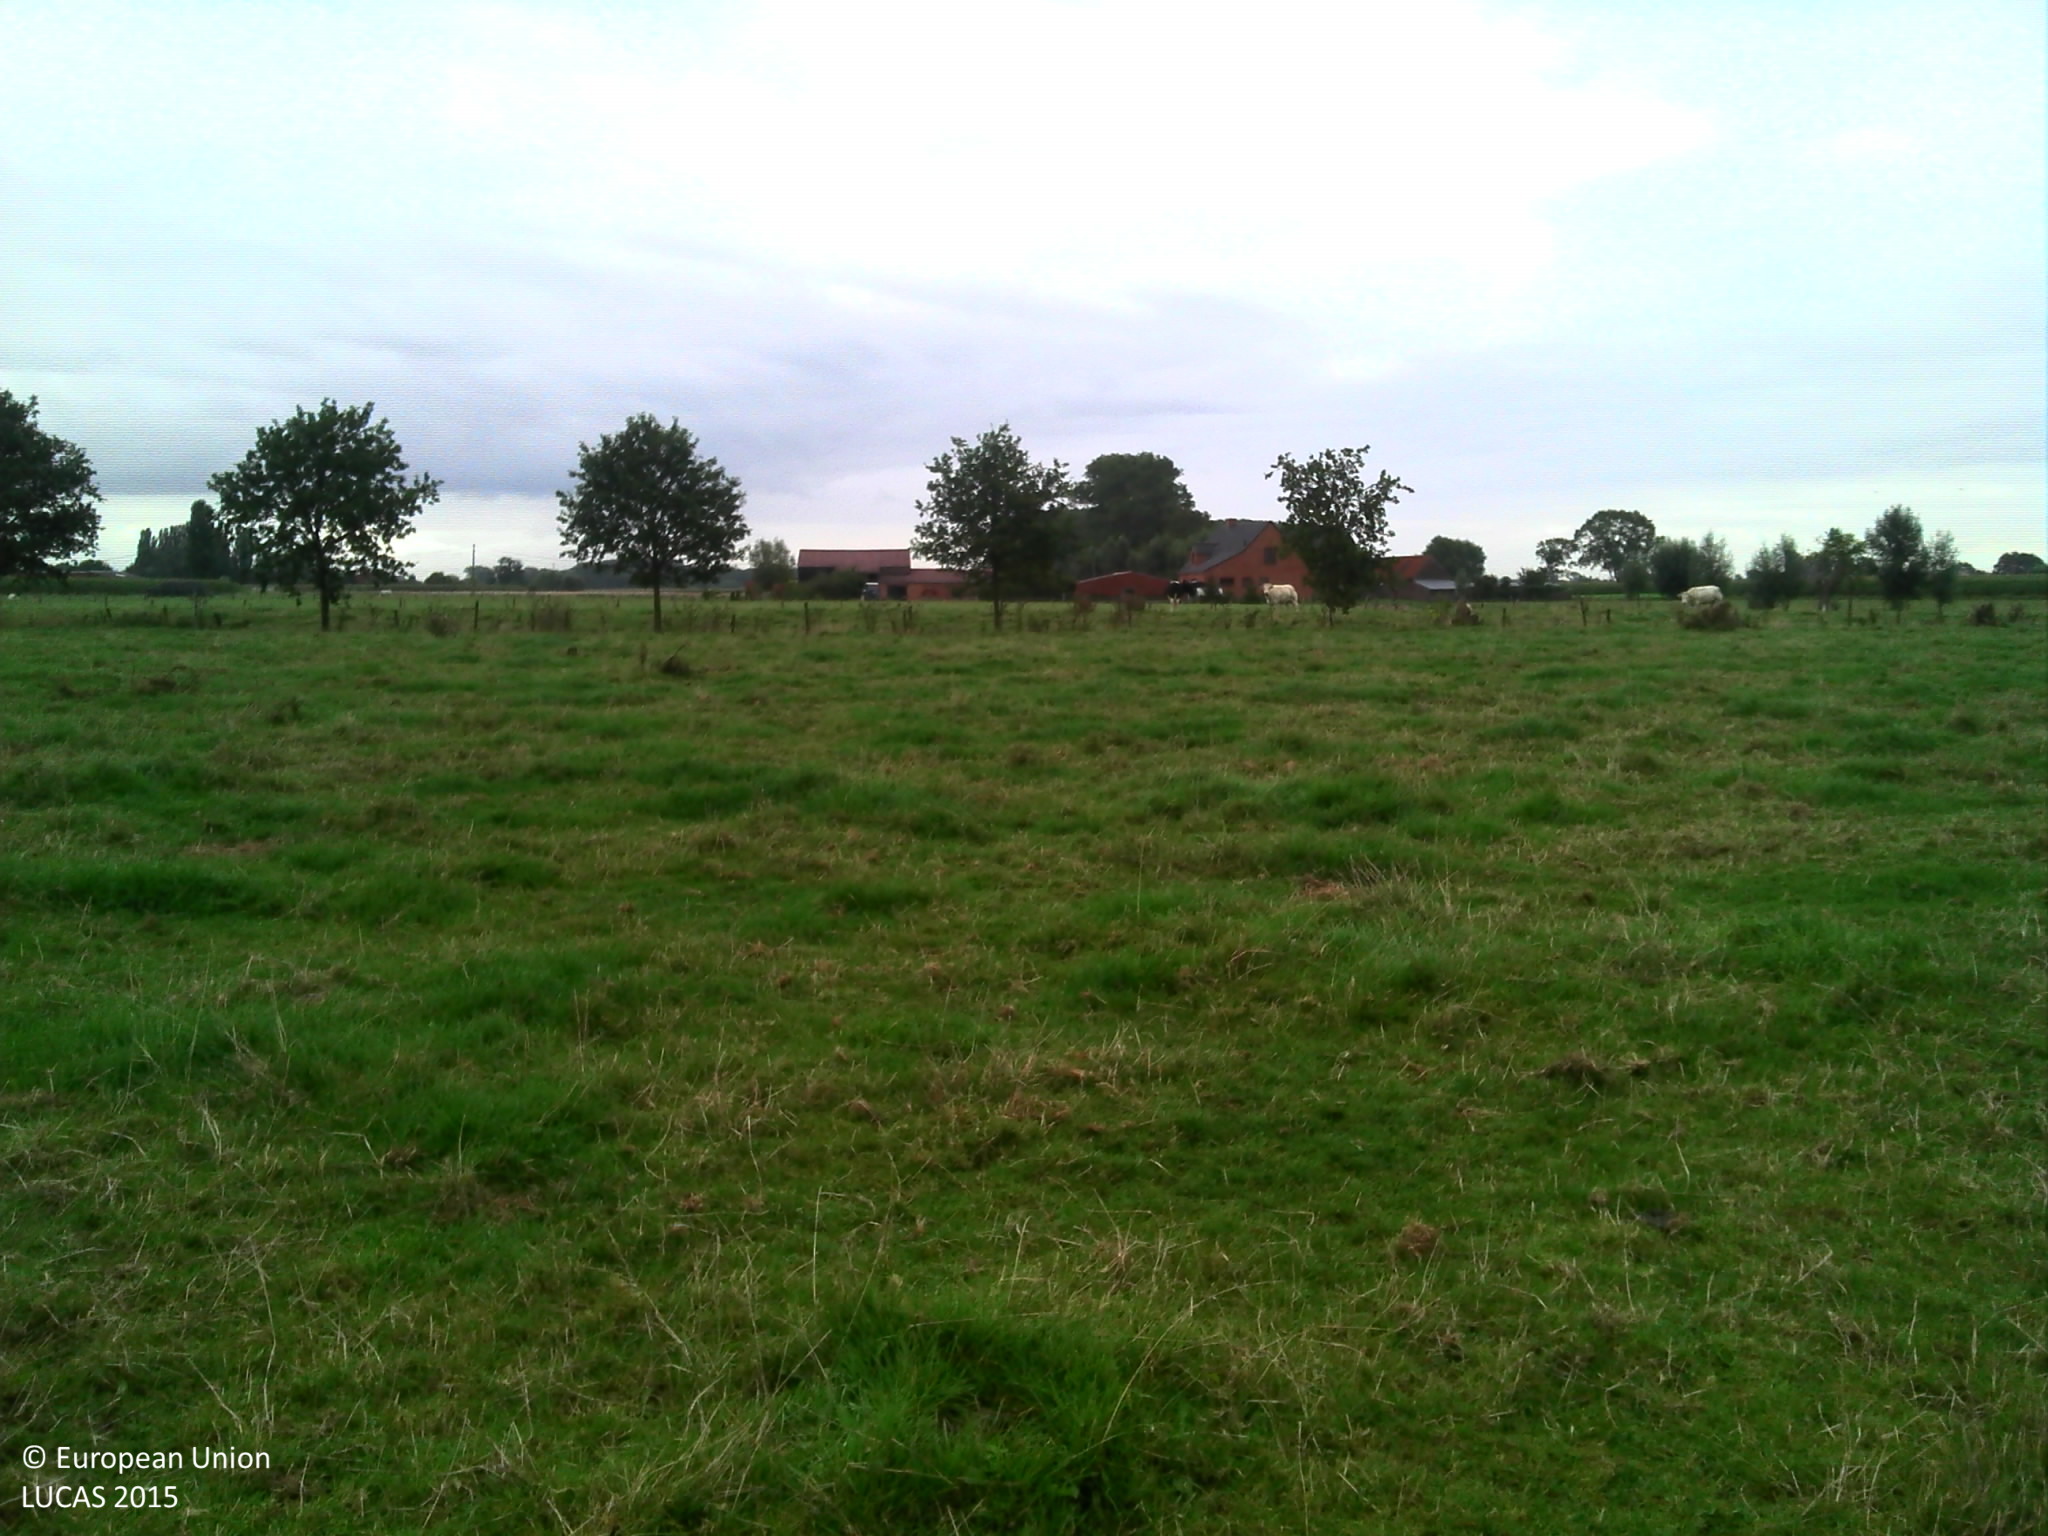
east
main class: Grassland
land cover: Grassland without tree/shrub cover
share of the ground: > 75 %
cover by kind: herbaceous plants 100 %
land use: Agriculture (excluding fallow land and kitchen gardens)
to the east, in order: Grassland without tree/shrub cover; Fences; Grassland without tree/shrub cover; Fences; Grassland without tree/shrub cover; Artificial constructions in urban areas; Grassland without tree/shrub cover; Electric lines; Grassland without tree/shrub cover; Fences; Grassland without tree/shrub cover
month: September
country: BE
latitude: 51.0403
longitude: 3.4170
